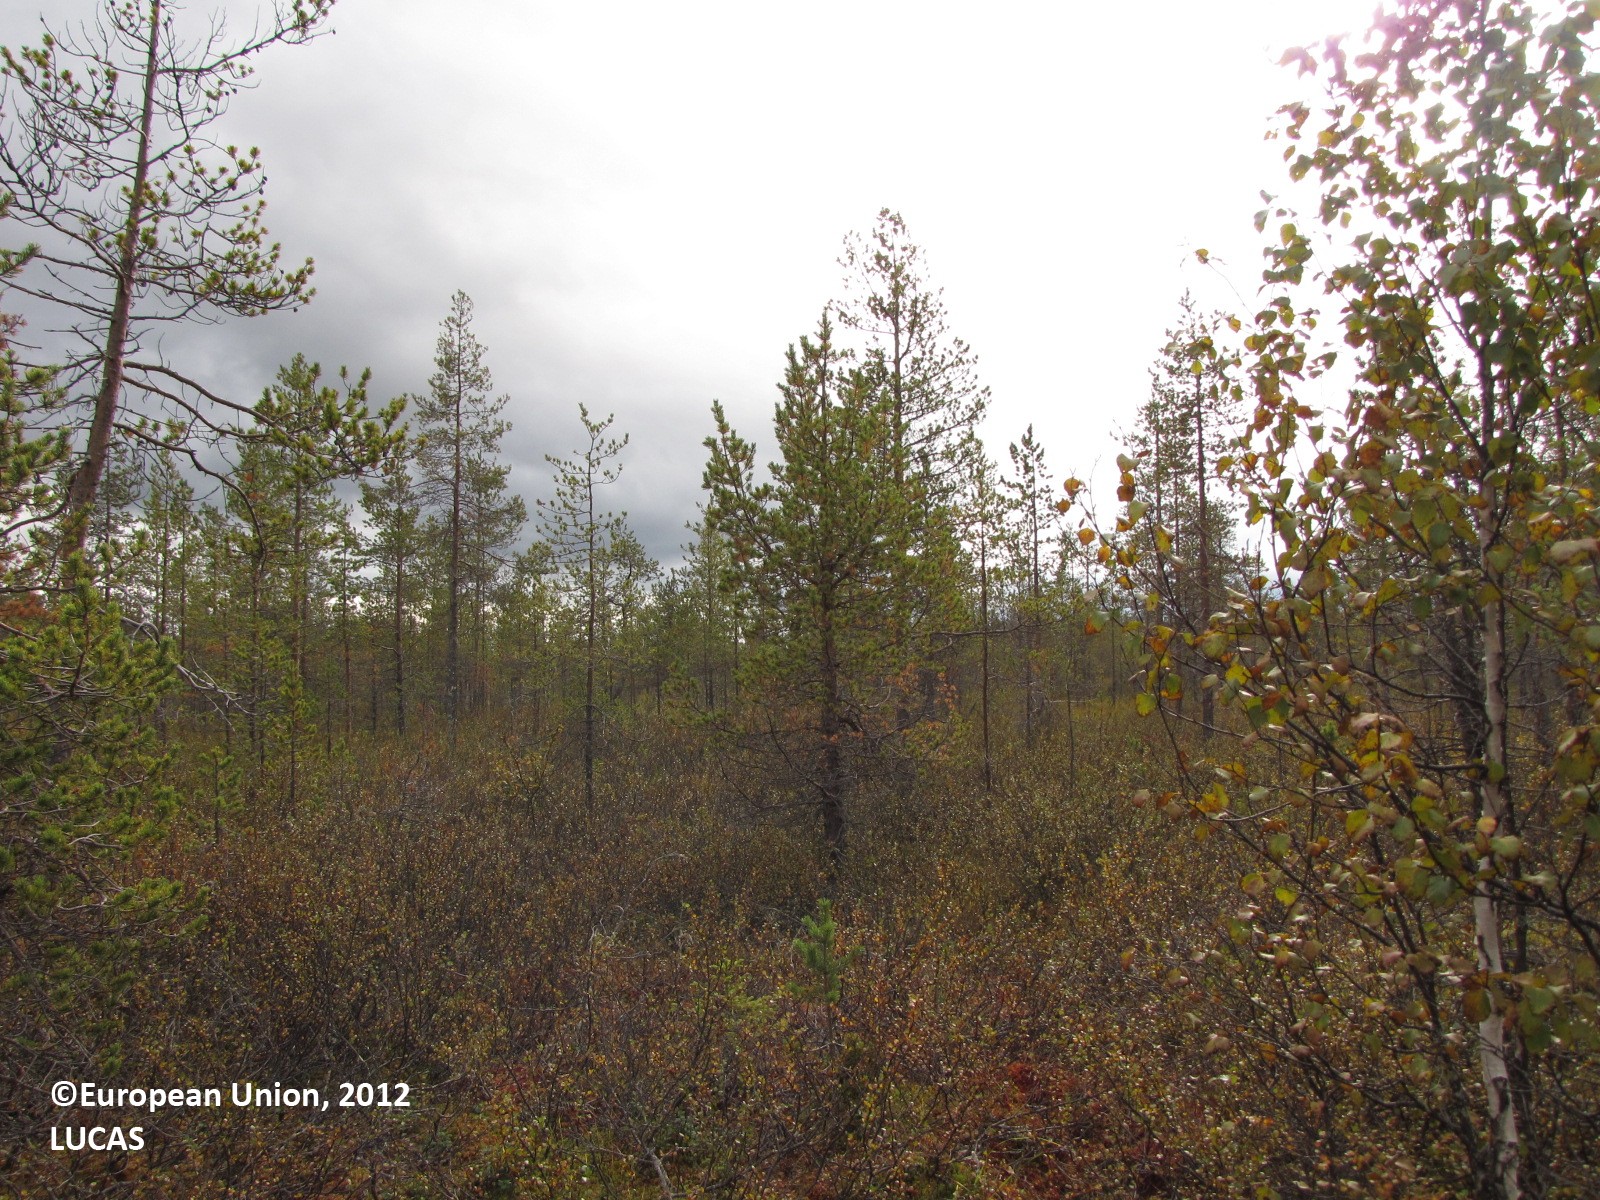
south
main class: Woodland
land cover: Pine dominated mixed woodland
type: boreal forest
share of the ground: 25 - 50 %
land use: Forestry
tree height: > 5 m
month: September
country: FI
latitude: 67.2227
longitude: 23.9838
